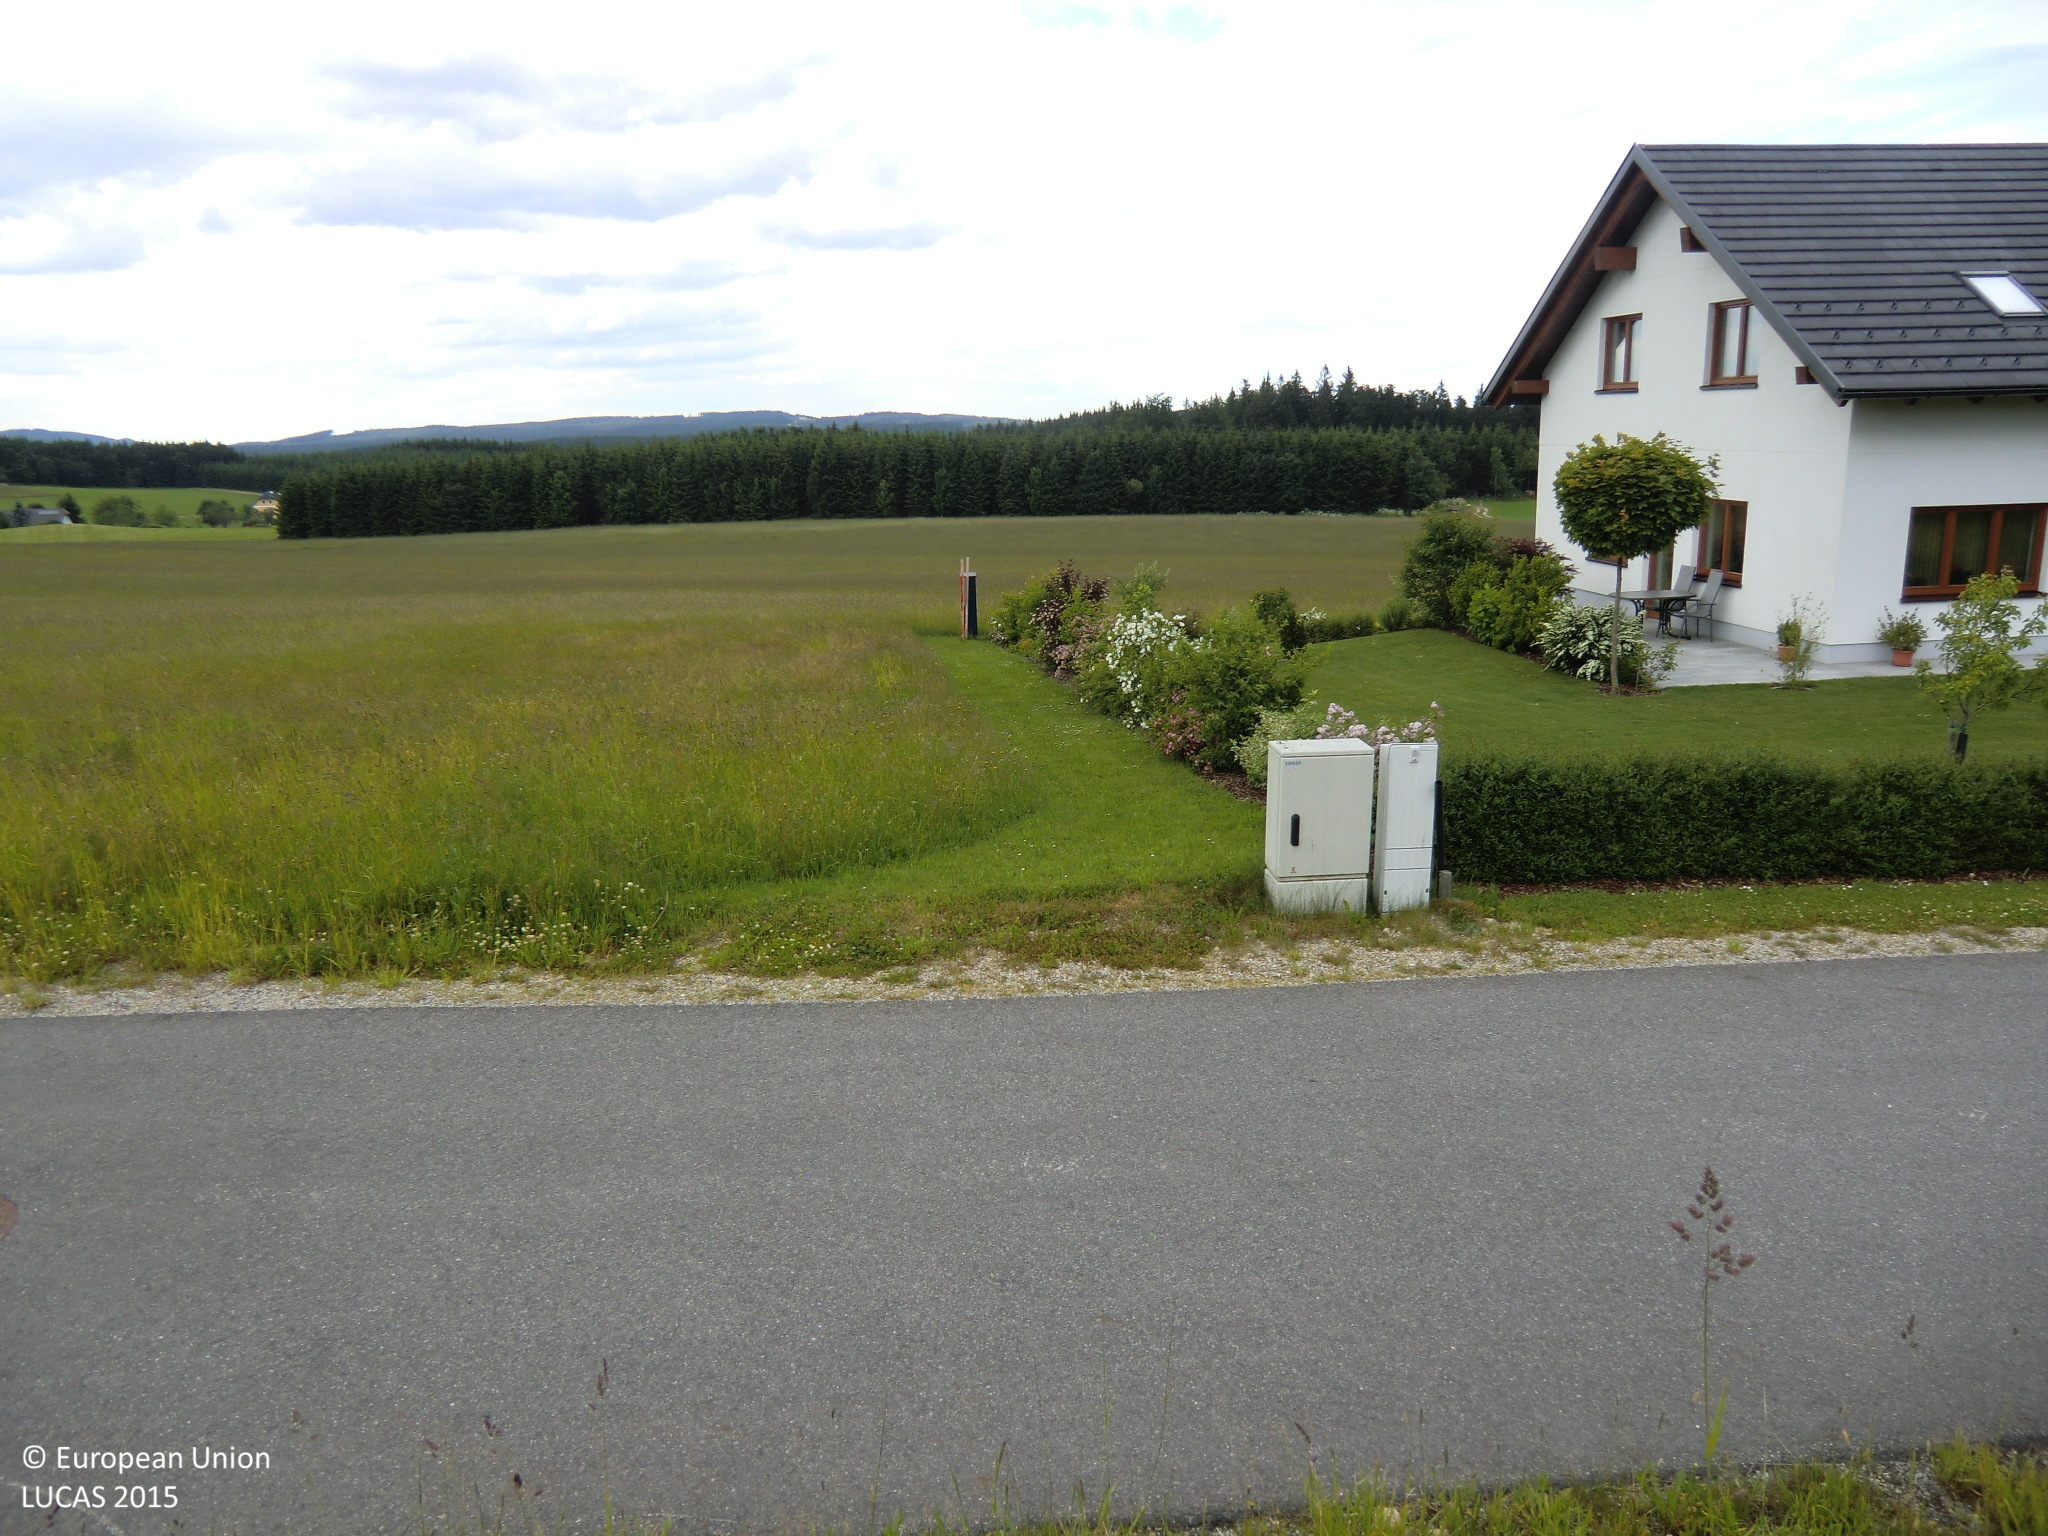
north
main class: Grassland
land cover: Grassland without tree/shrub cover
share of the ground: > 75 %
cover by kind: herbaceous plants 100 %
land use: Agriculture (excluding fallow land and kitchen gardens)
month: June
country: AT
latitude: 48.5332
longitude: 14.8089
